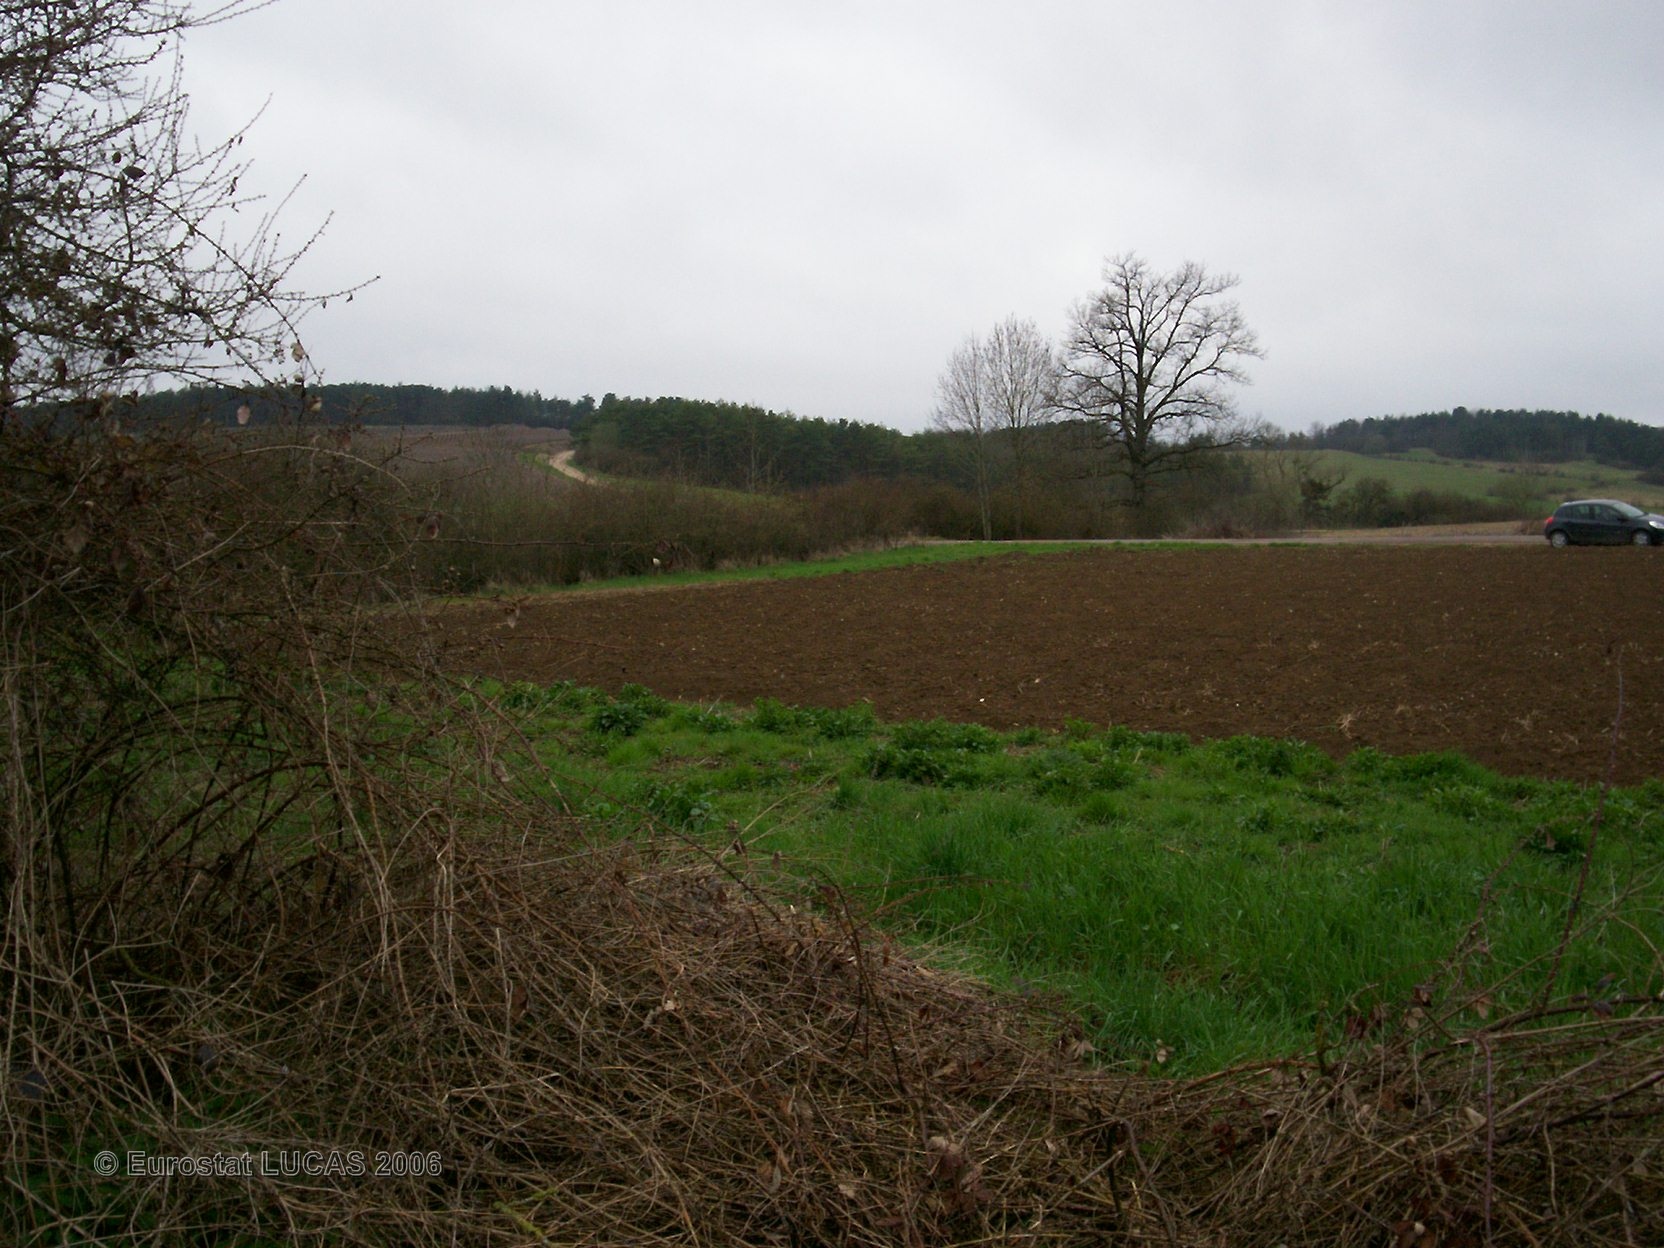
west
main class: Cropland
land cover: Common wheat
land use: Agriculture (excluding fallow land and kitchen gardens)
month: April
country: FR
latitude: 48.0853
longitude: 4.4803
